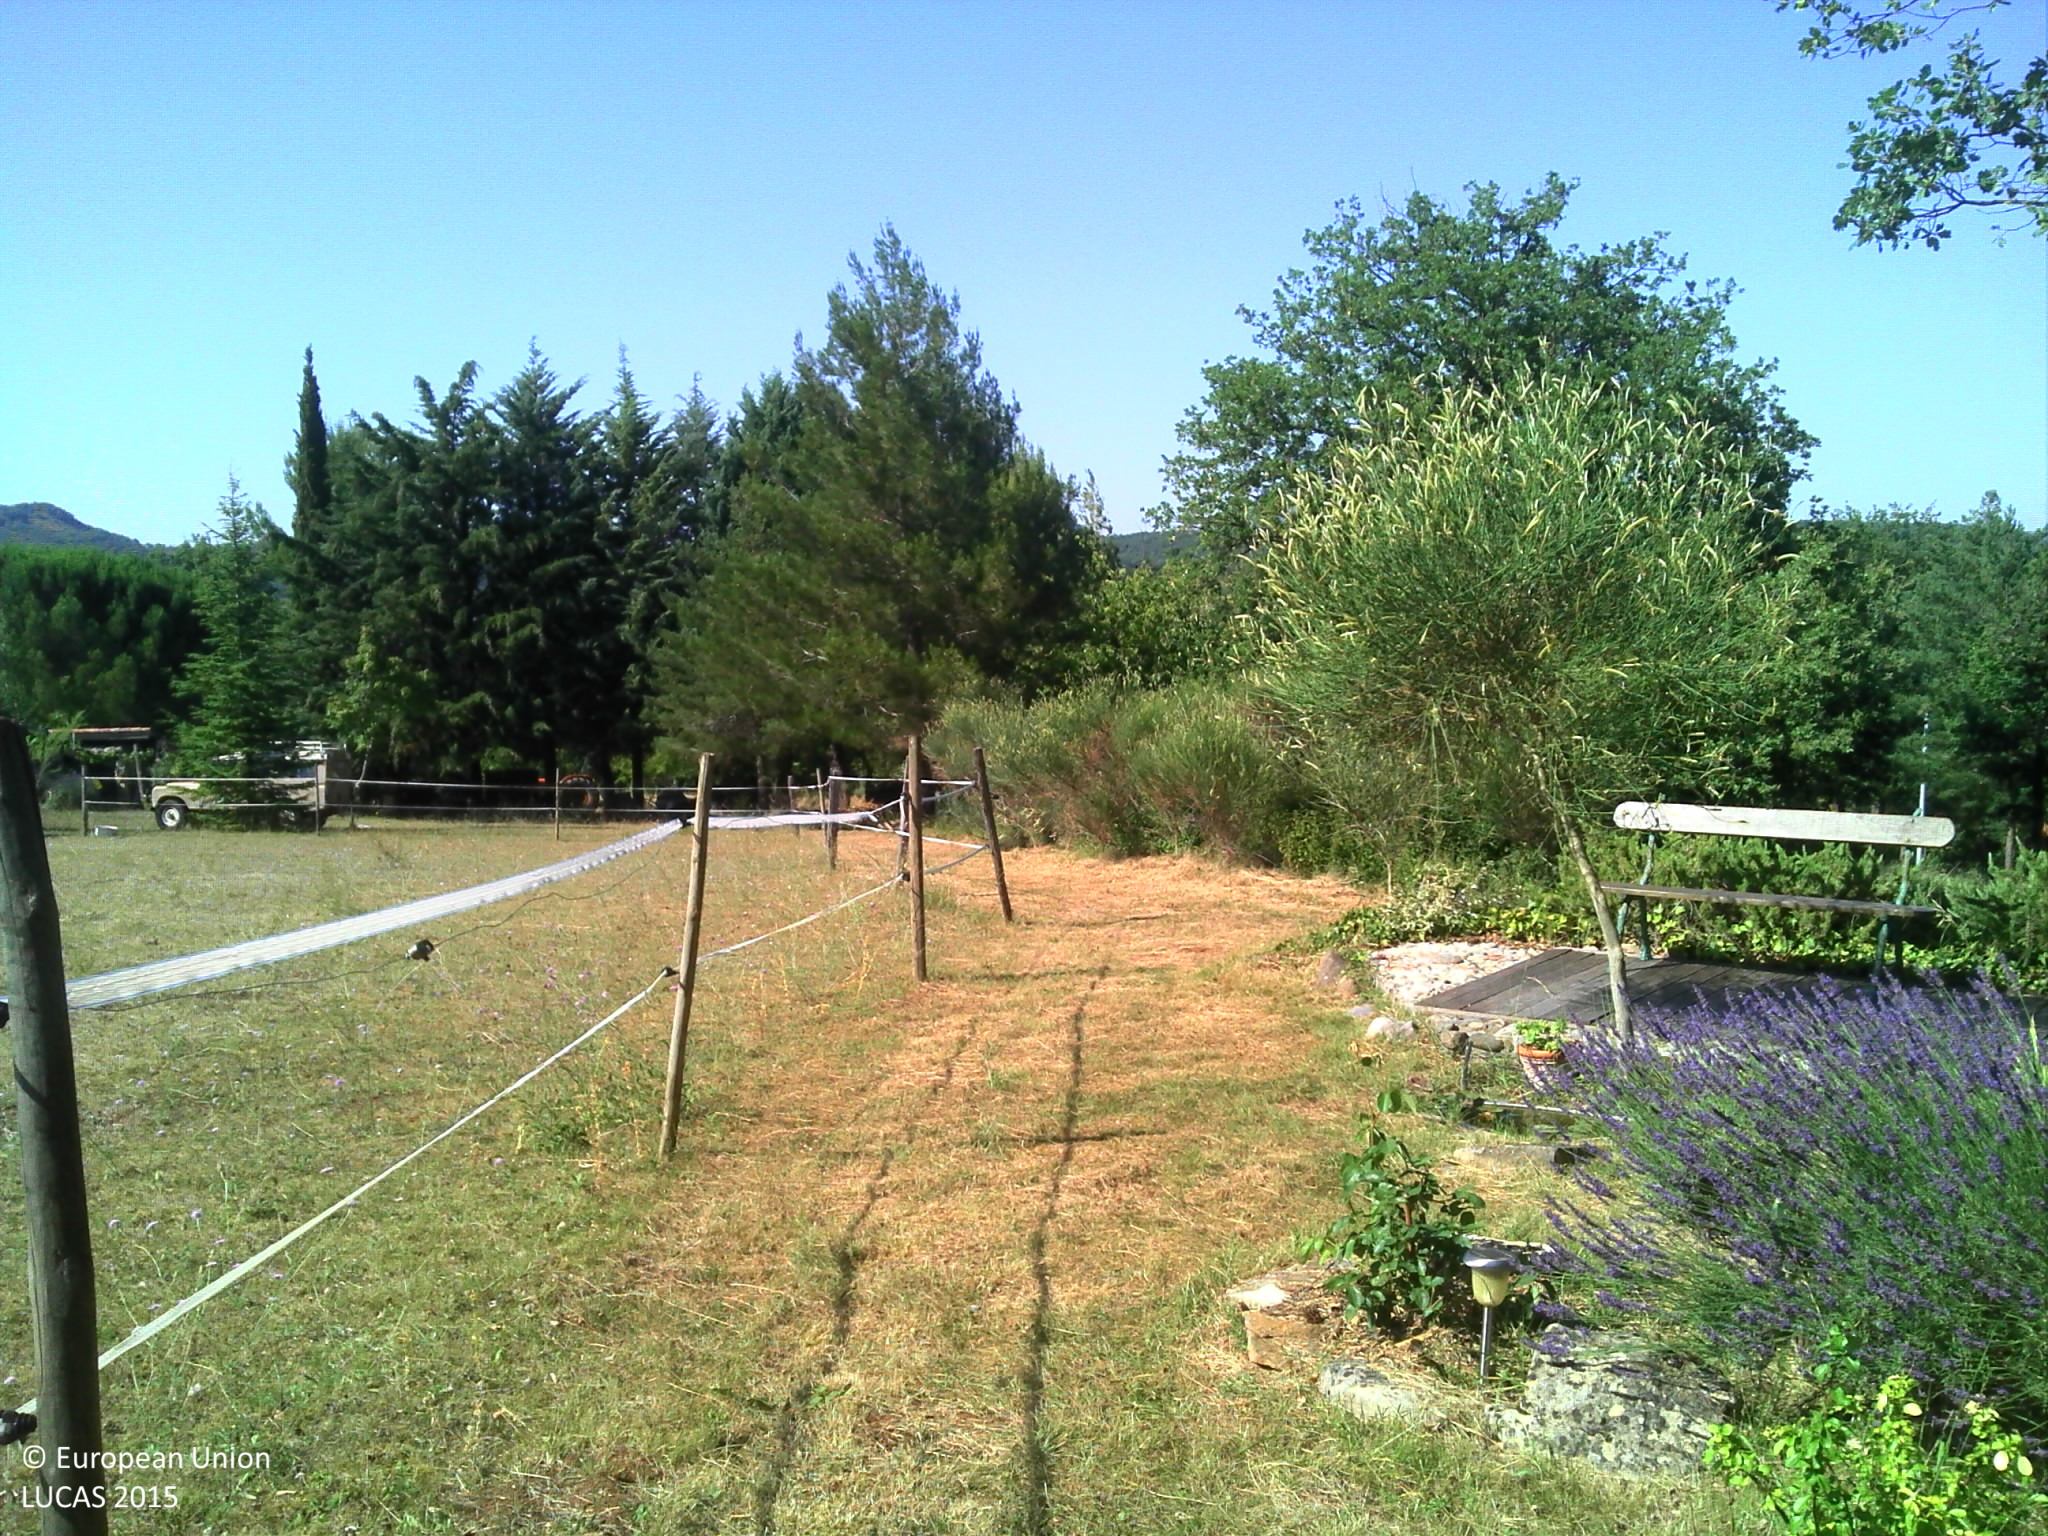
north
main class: Grassland
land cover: Grassland with sparse tree/shrub cover
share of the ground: > 75 %
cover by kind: herbaceous plants 95 %, coniferous forest trees 5 %
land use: Agriculture (excluding fallow land and kitchen gardens)
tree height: > 5 m
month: July
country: FR
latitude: 42.9297
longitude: 2.1550
